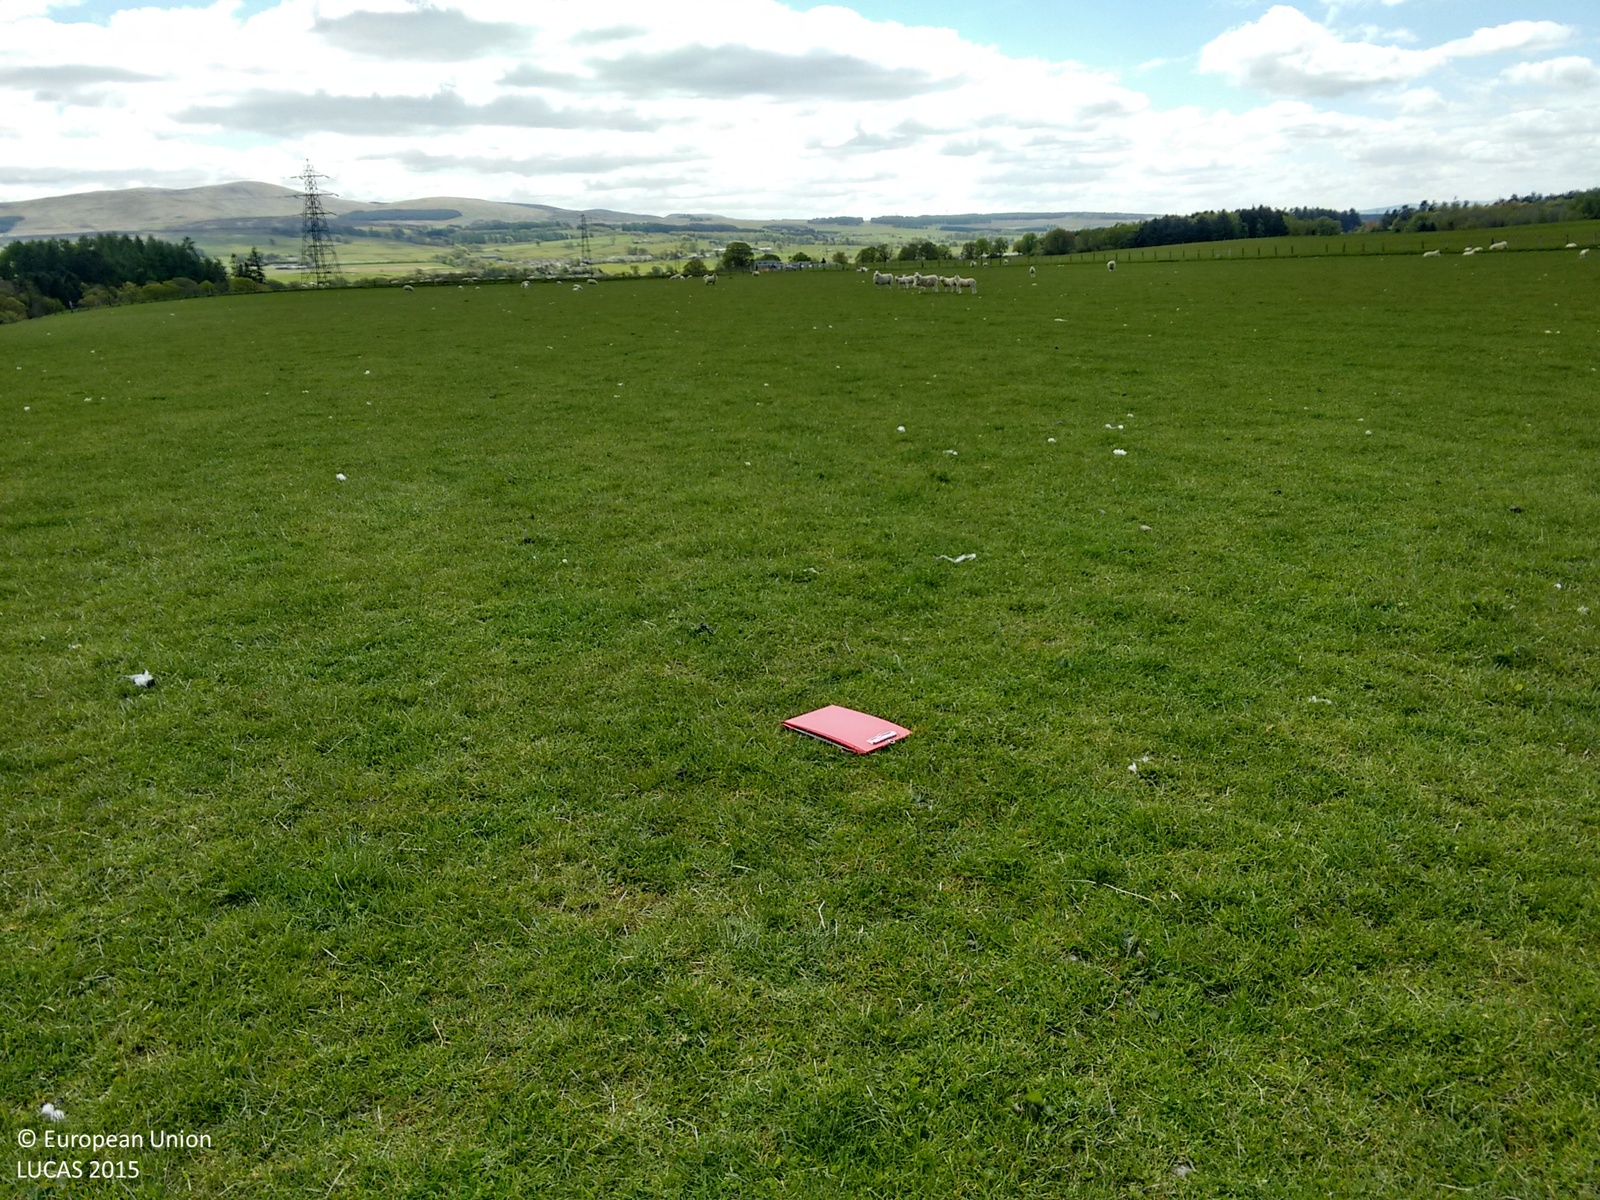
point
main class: Grassland
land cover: Grassland without tree/shrub cover
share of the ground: > 75 %
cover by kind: herbaceous plants 100 %
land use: Agriculture (excluding fallow land and kitchen gardens)
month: May
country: GB
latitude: 56.2681
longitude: -3.8894
